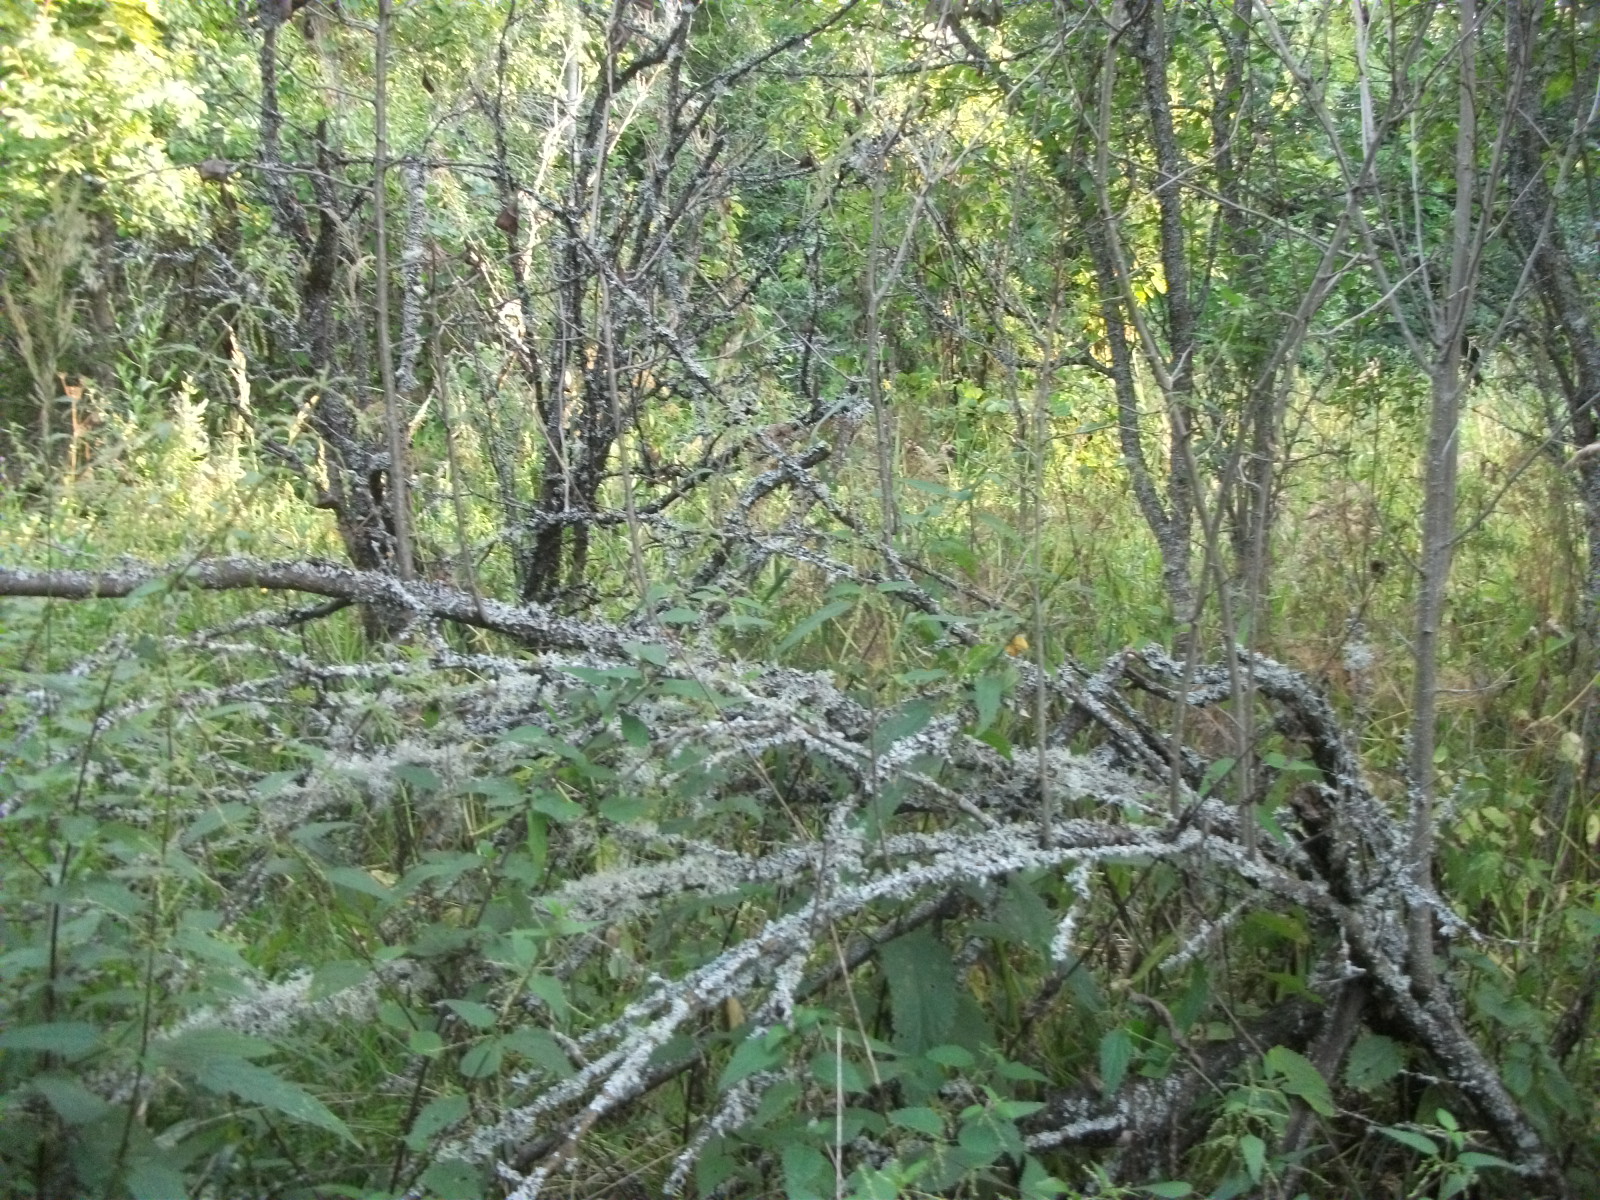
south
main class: Cropland
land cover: Other fruit trees and berries
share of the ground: 25 - 50 %
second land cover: Spontaneously vegetated surfaces
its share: > 75 %
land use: Abandoned areas
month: August
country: LV
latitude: 56.5129
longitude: 26.3119
